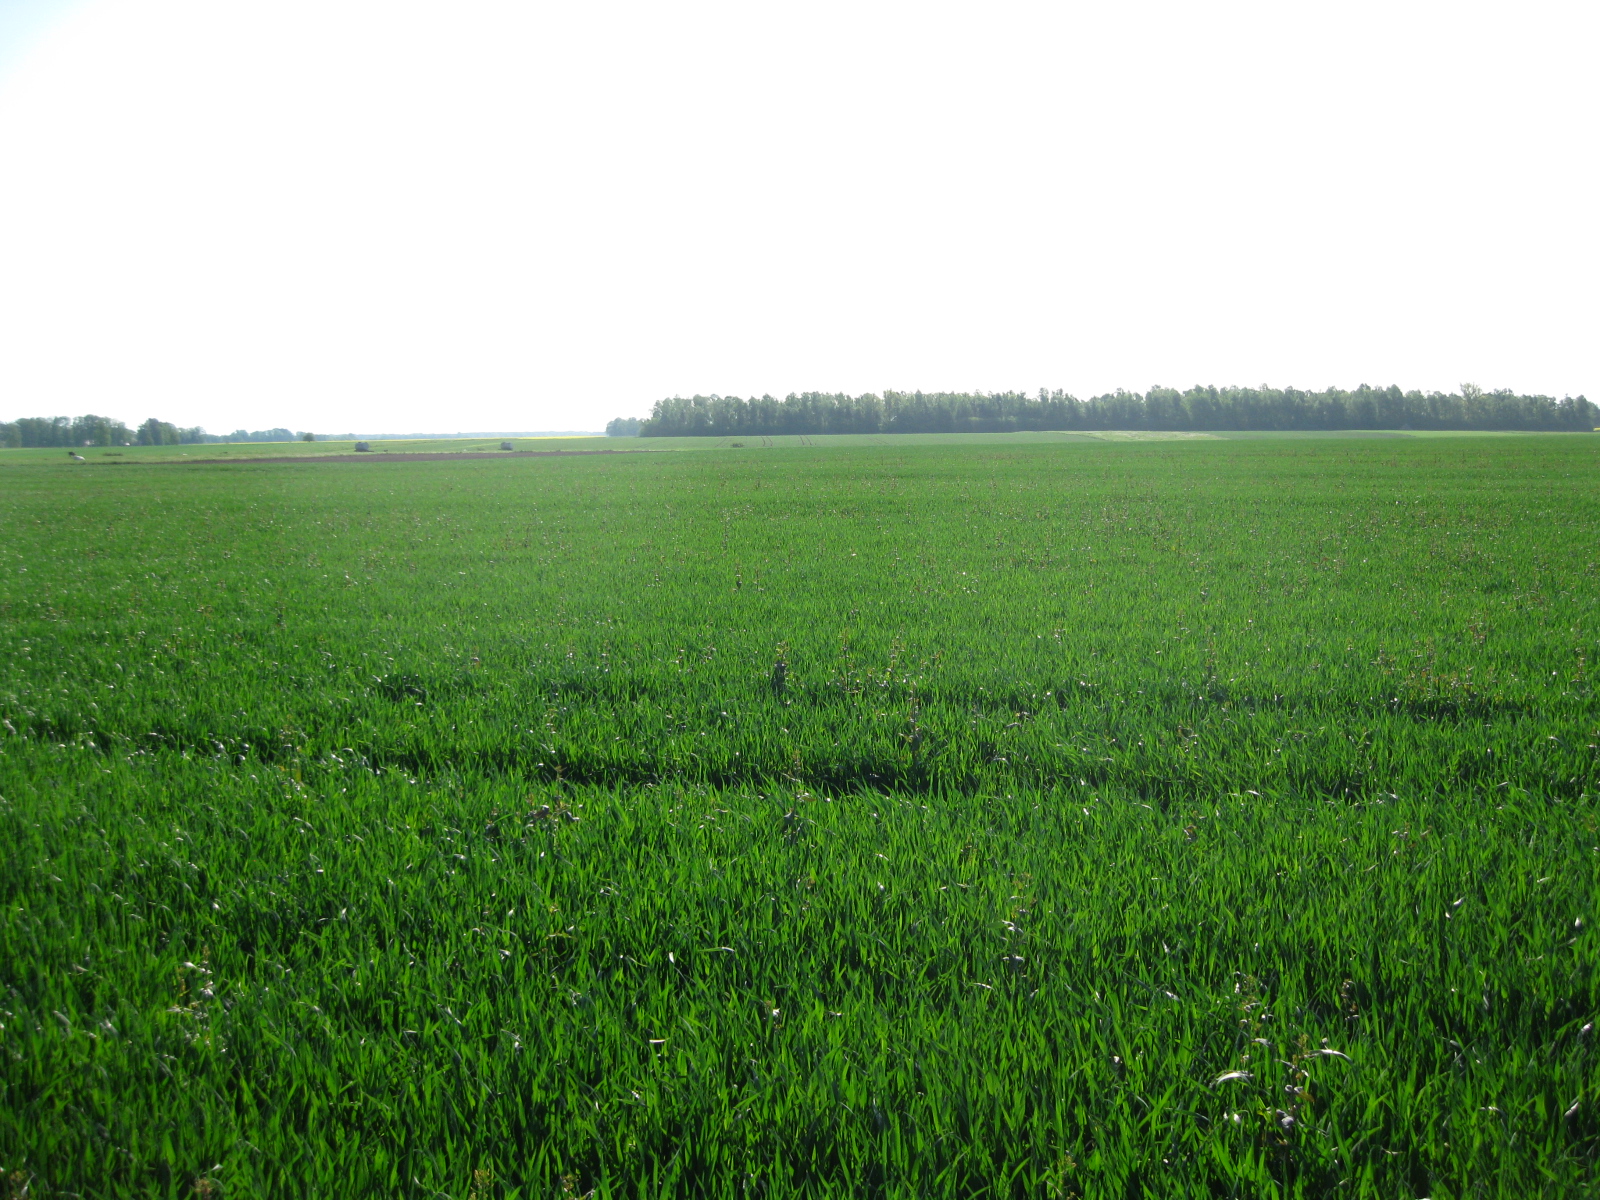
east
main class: Cropland
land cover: Common wheat
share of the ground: > 75 %
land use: Agriculture (excluding fallow land and kitchen gardens)
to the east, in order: Common wheat
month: May
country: LT
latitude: 56.0750
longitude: 24.1478
